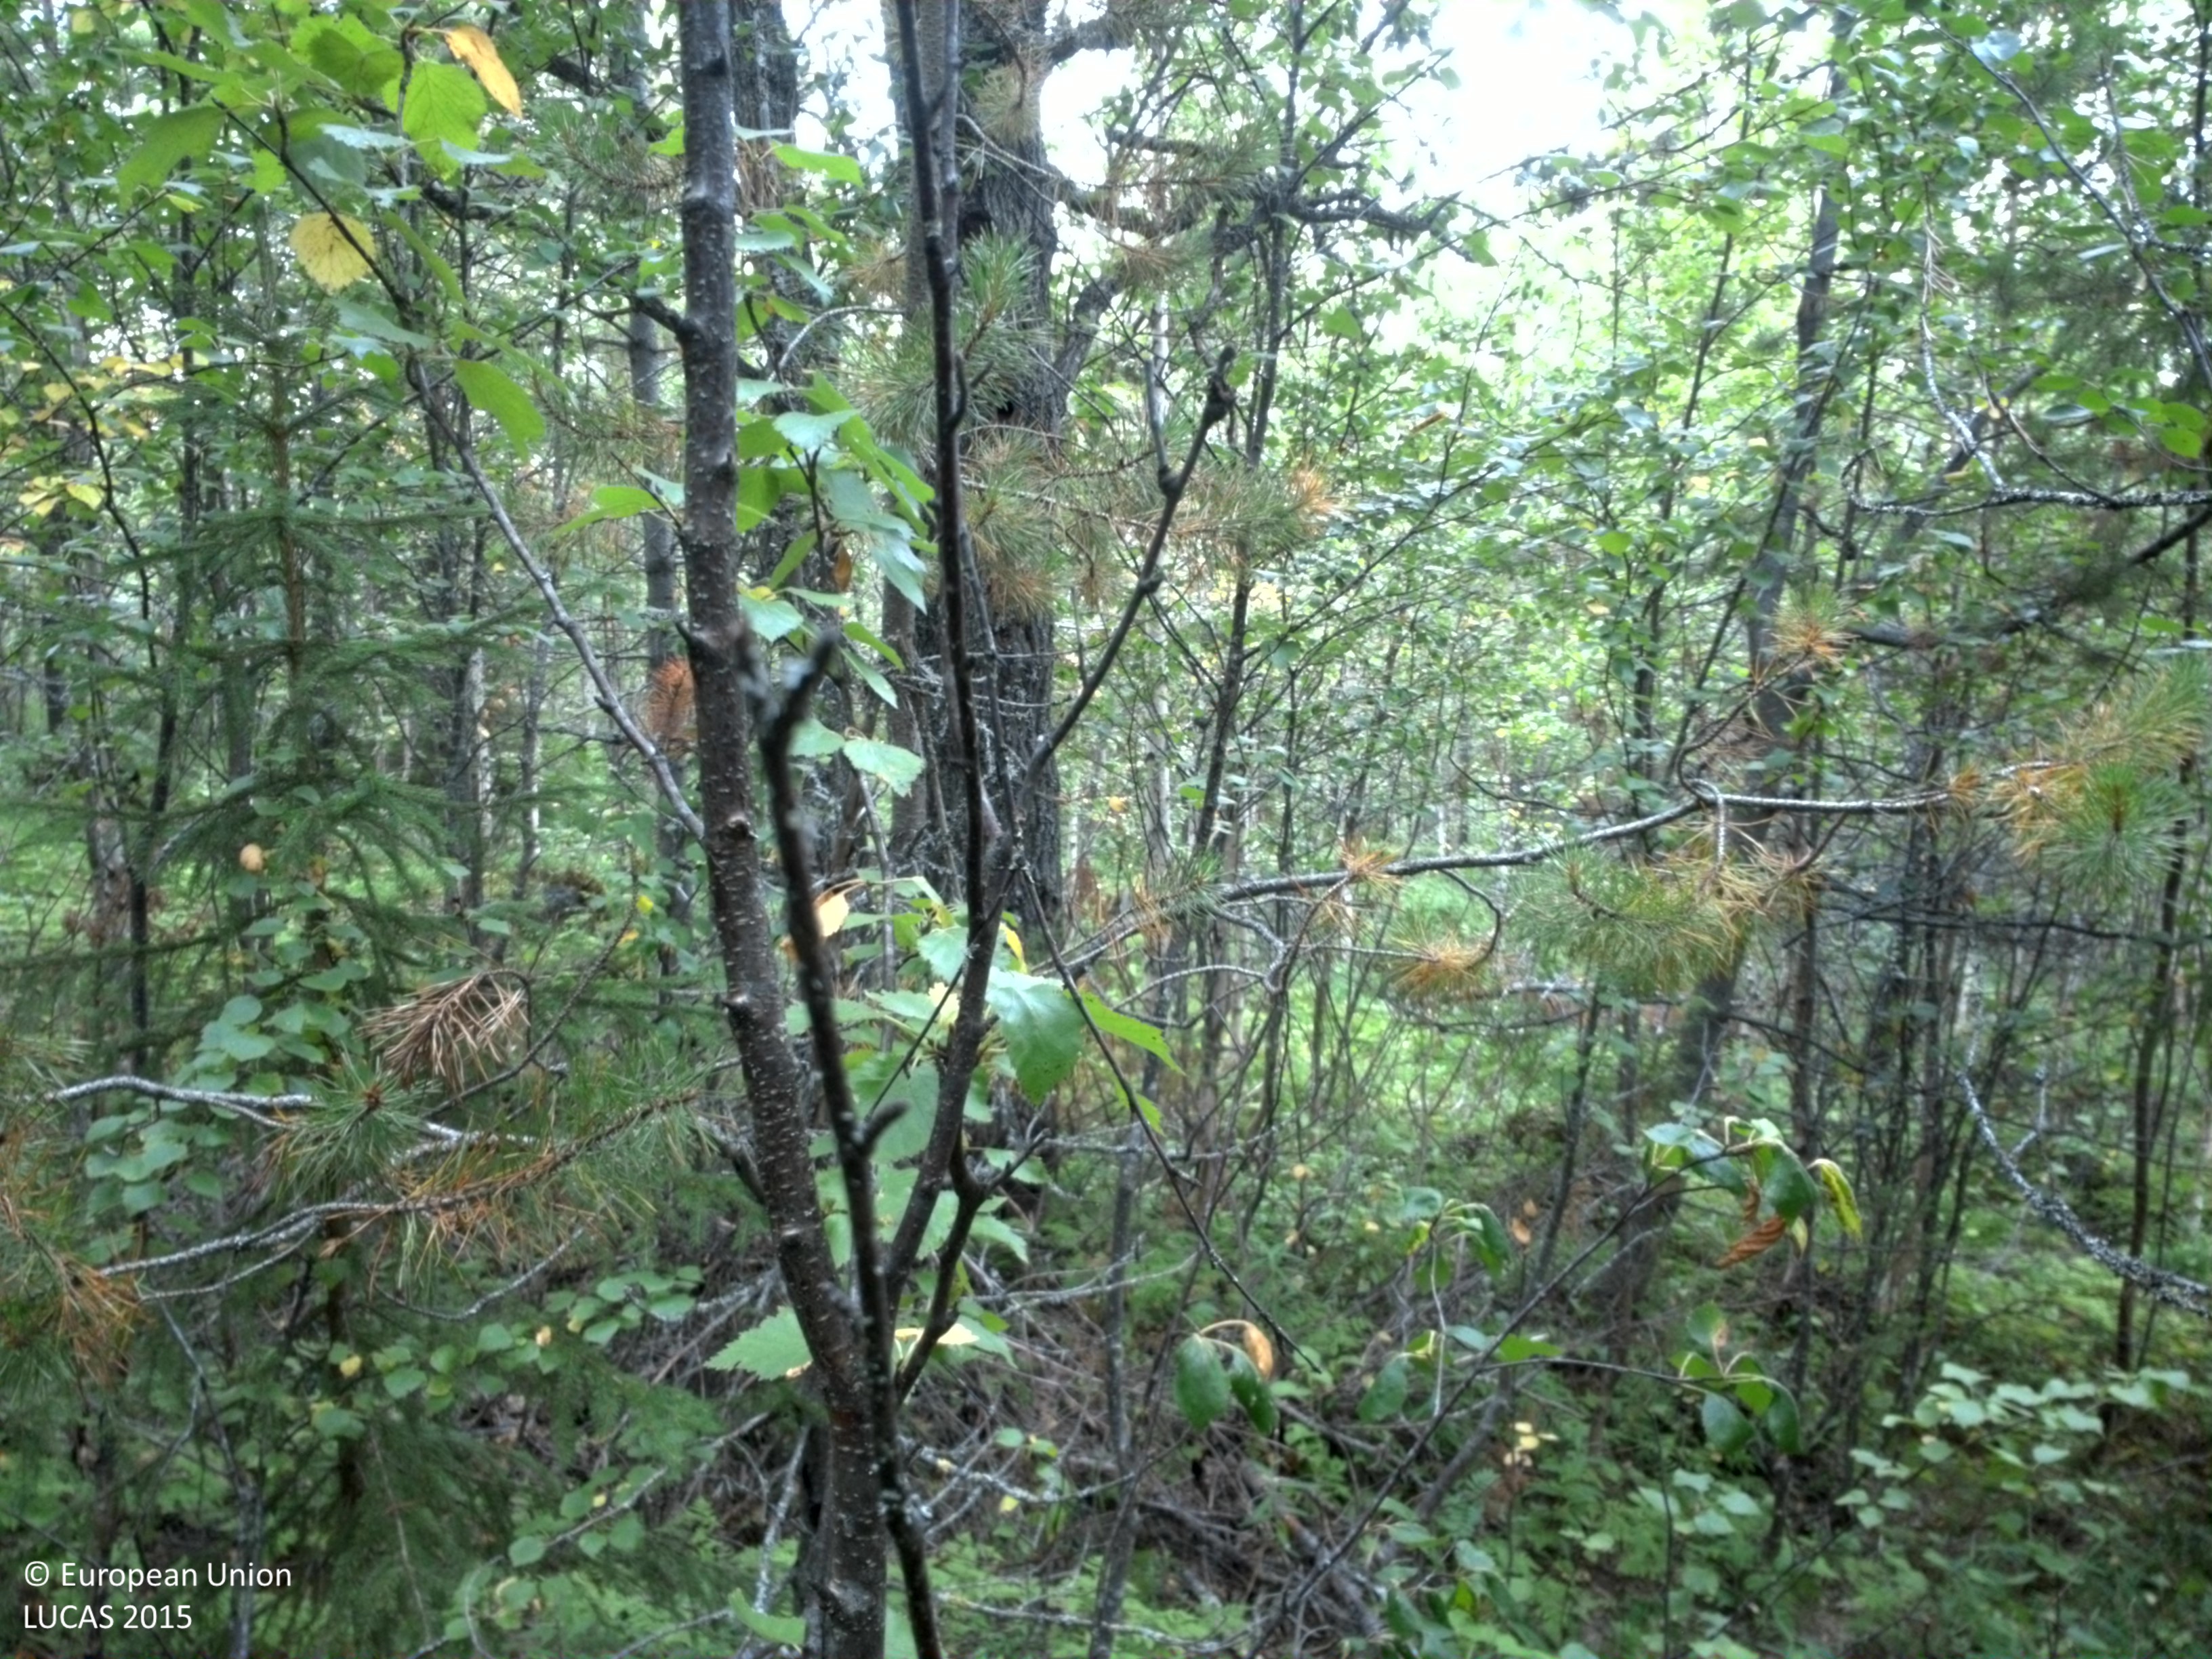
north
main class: Woodland
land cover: Other mixed woodland
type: exotic forest
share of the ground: 50 - 75 %
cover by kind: coniferous forest trees 30 %, broadleaved forest trees 30 %, shrubs 25 %, herbaceous plants 15 %
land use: Forestry
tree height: > 5 m
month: August
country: SE
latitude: 64.8356
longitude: 16.7312
